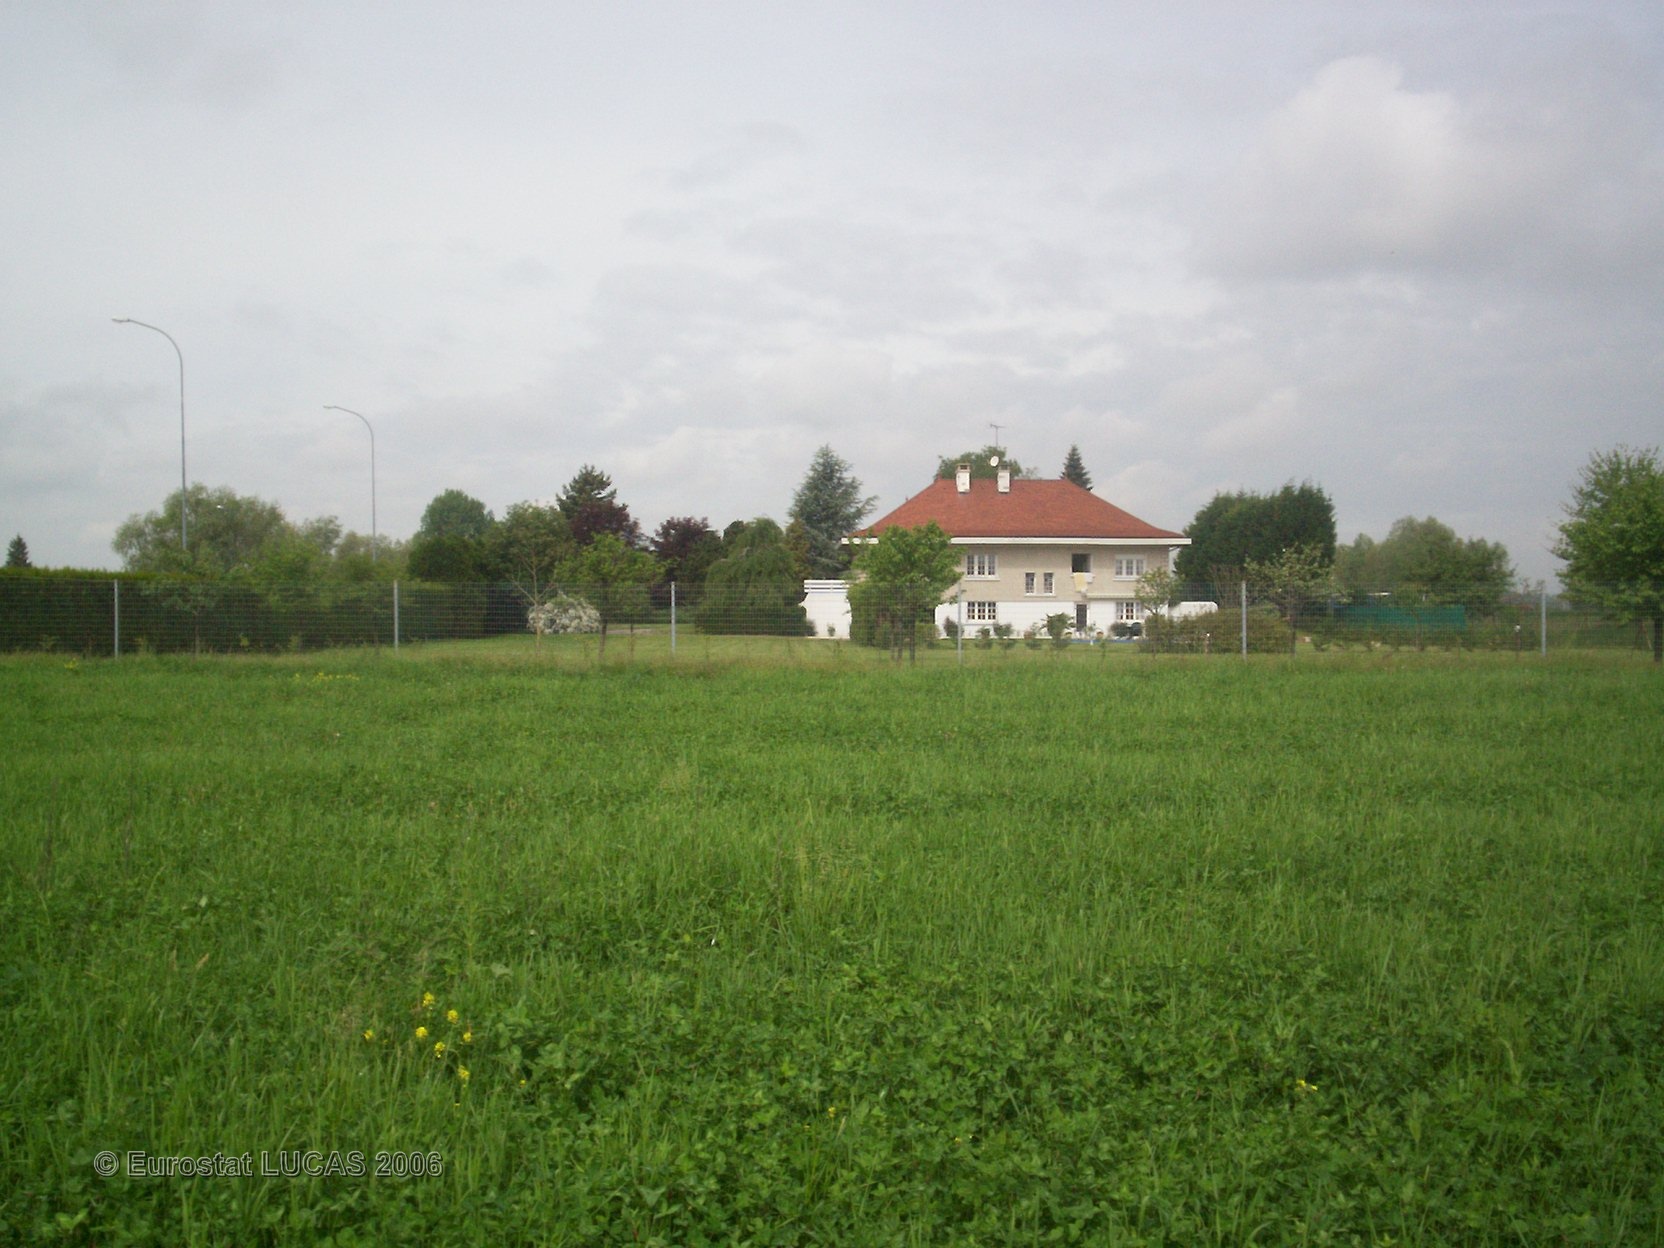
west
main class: Cropland
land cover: Clovers
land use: Agriculture (excluding fallow land and kitchen gardens)
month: May
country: FR
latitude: 48.6610
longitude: 4.8251
